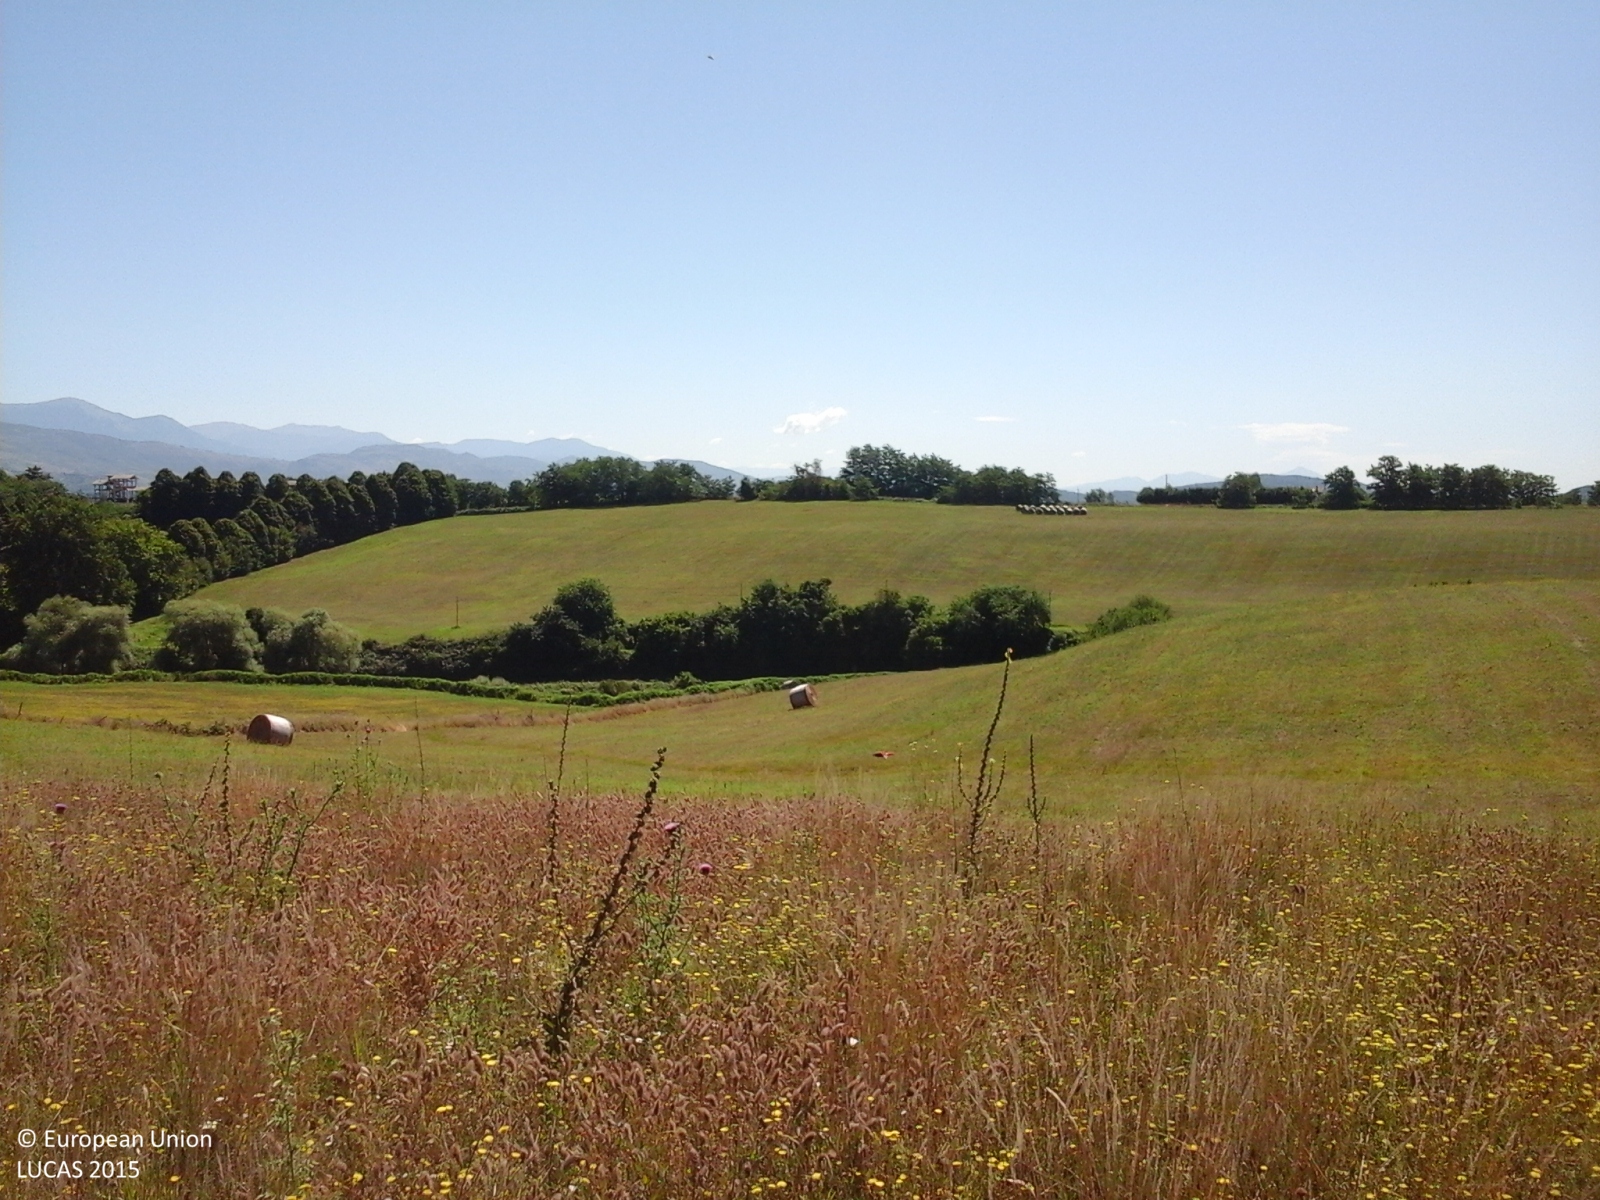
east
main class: Grassland
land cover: Grassland without tree/shrub cover
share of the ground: > 75 %
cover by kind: herbaceous plants 100 %
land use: Agriculture (excluding fallow land and kitchen gardens)
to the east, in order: Grassland without tree/shrub cover; Spontaneously vegetated surfaces; Grass margins; Shrubland with sparse tree cover; Ditches and canals; Shrubland with sparse tree cover; Grassland without tree/shrub cover
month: June
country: IT
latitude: 41.7033
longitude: 13.0768
